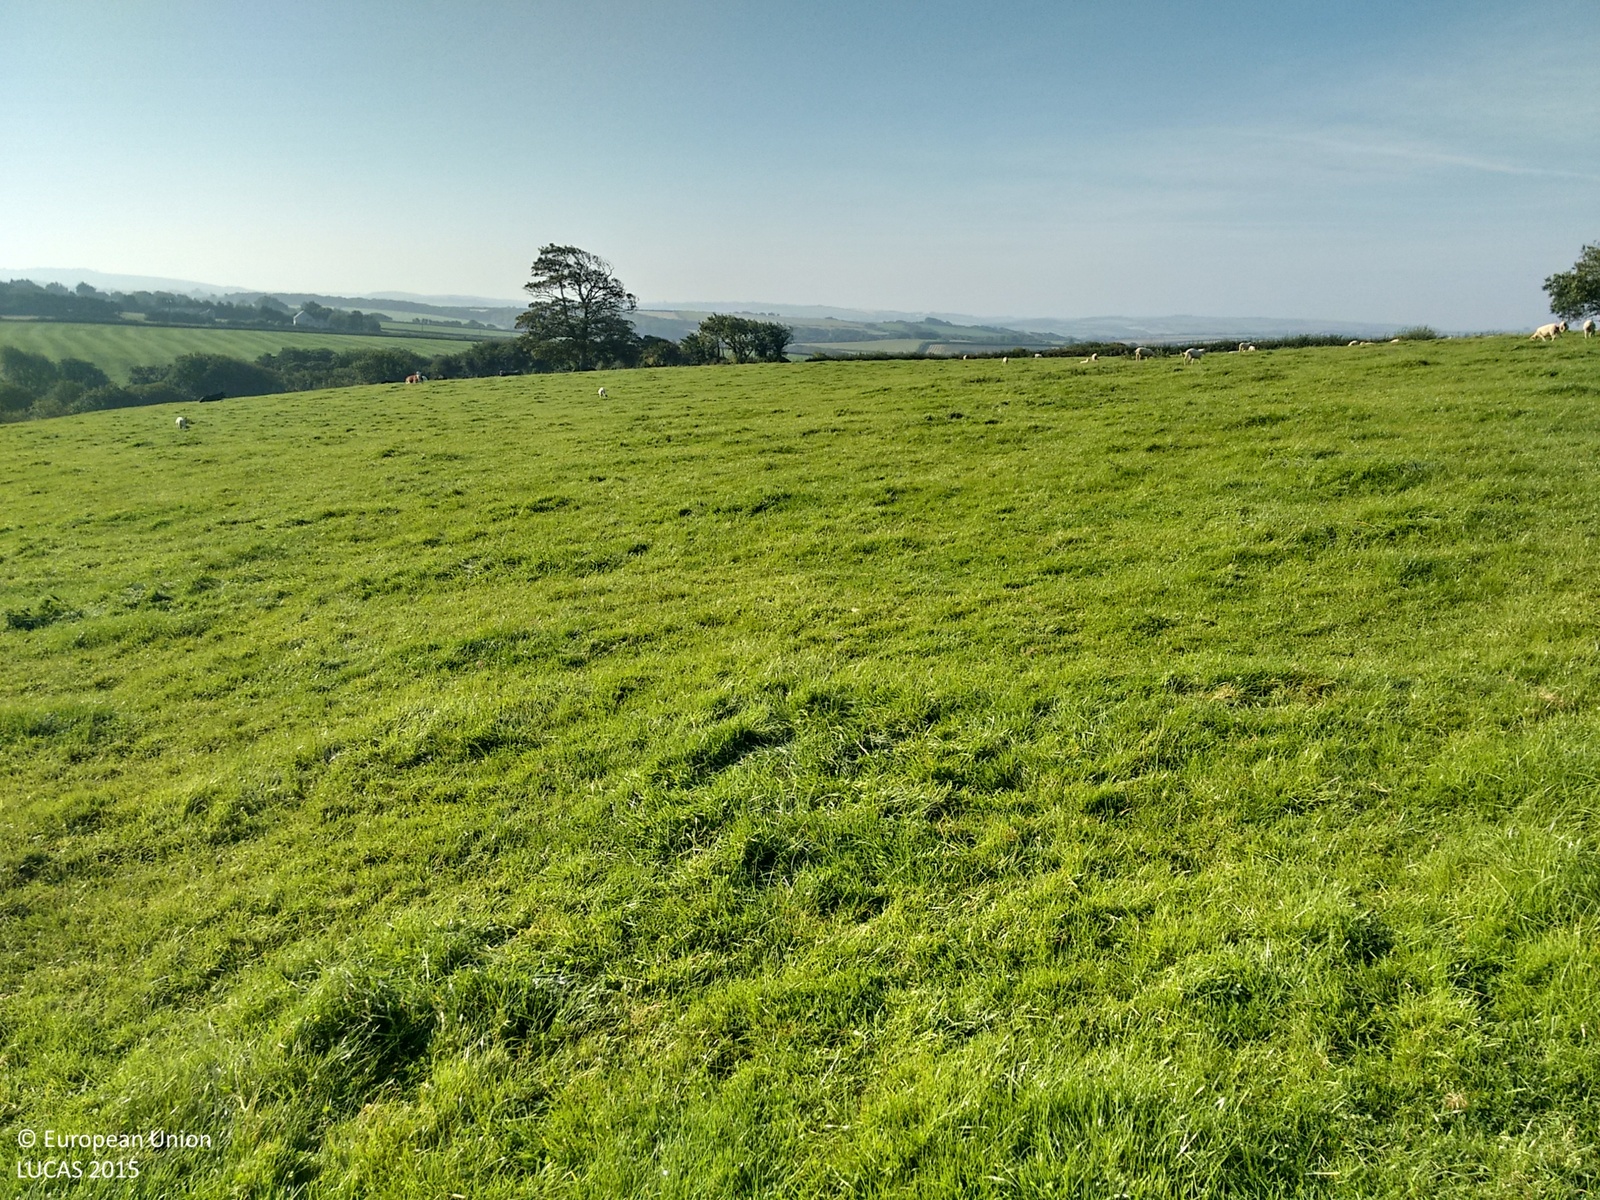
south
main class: Grassland
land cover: Grassland without tree/shrub cover
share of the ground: > 75 %
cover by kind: herbaceous plants 100 %
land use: Agriculture (excluding fallow land and kitchen gardens)
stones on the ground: < 10 %
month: September
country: GB
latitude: 50.8034
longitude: -4.5075
